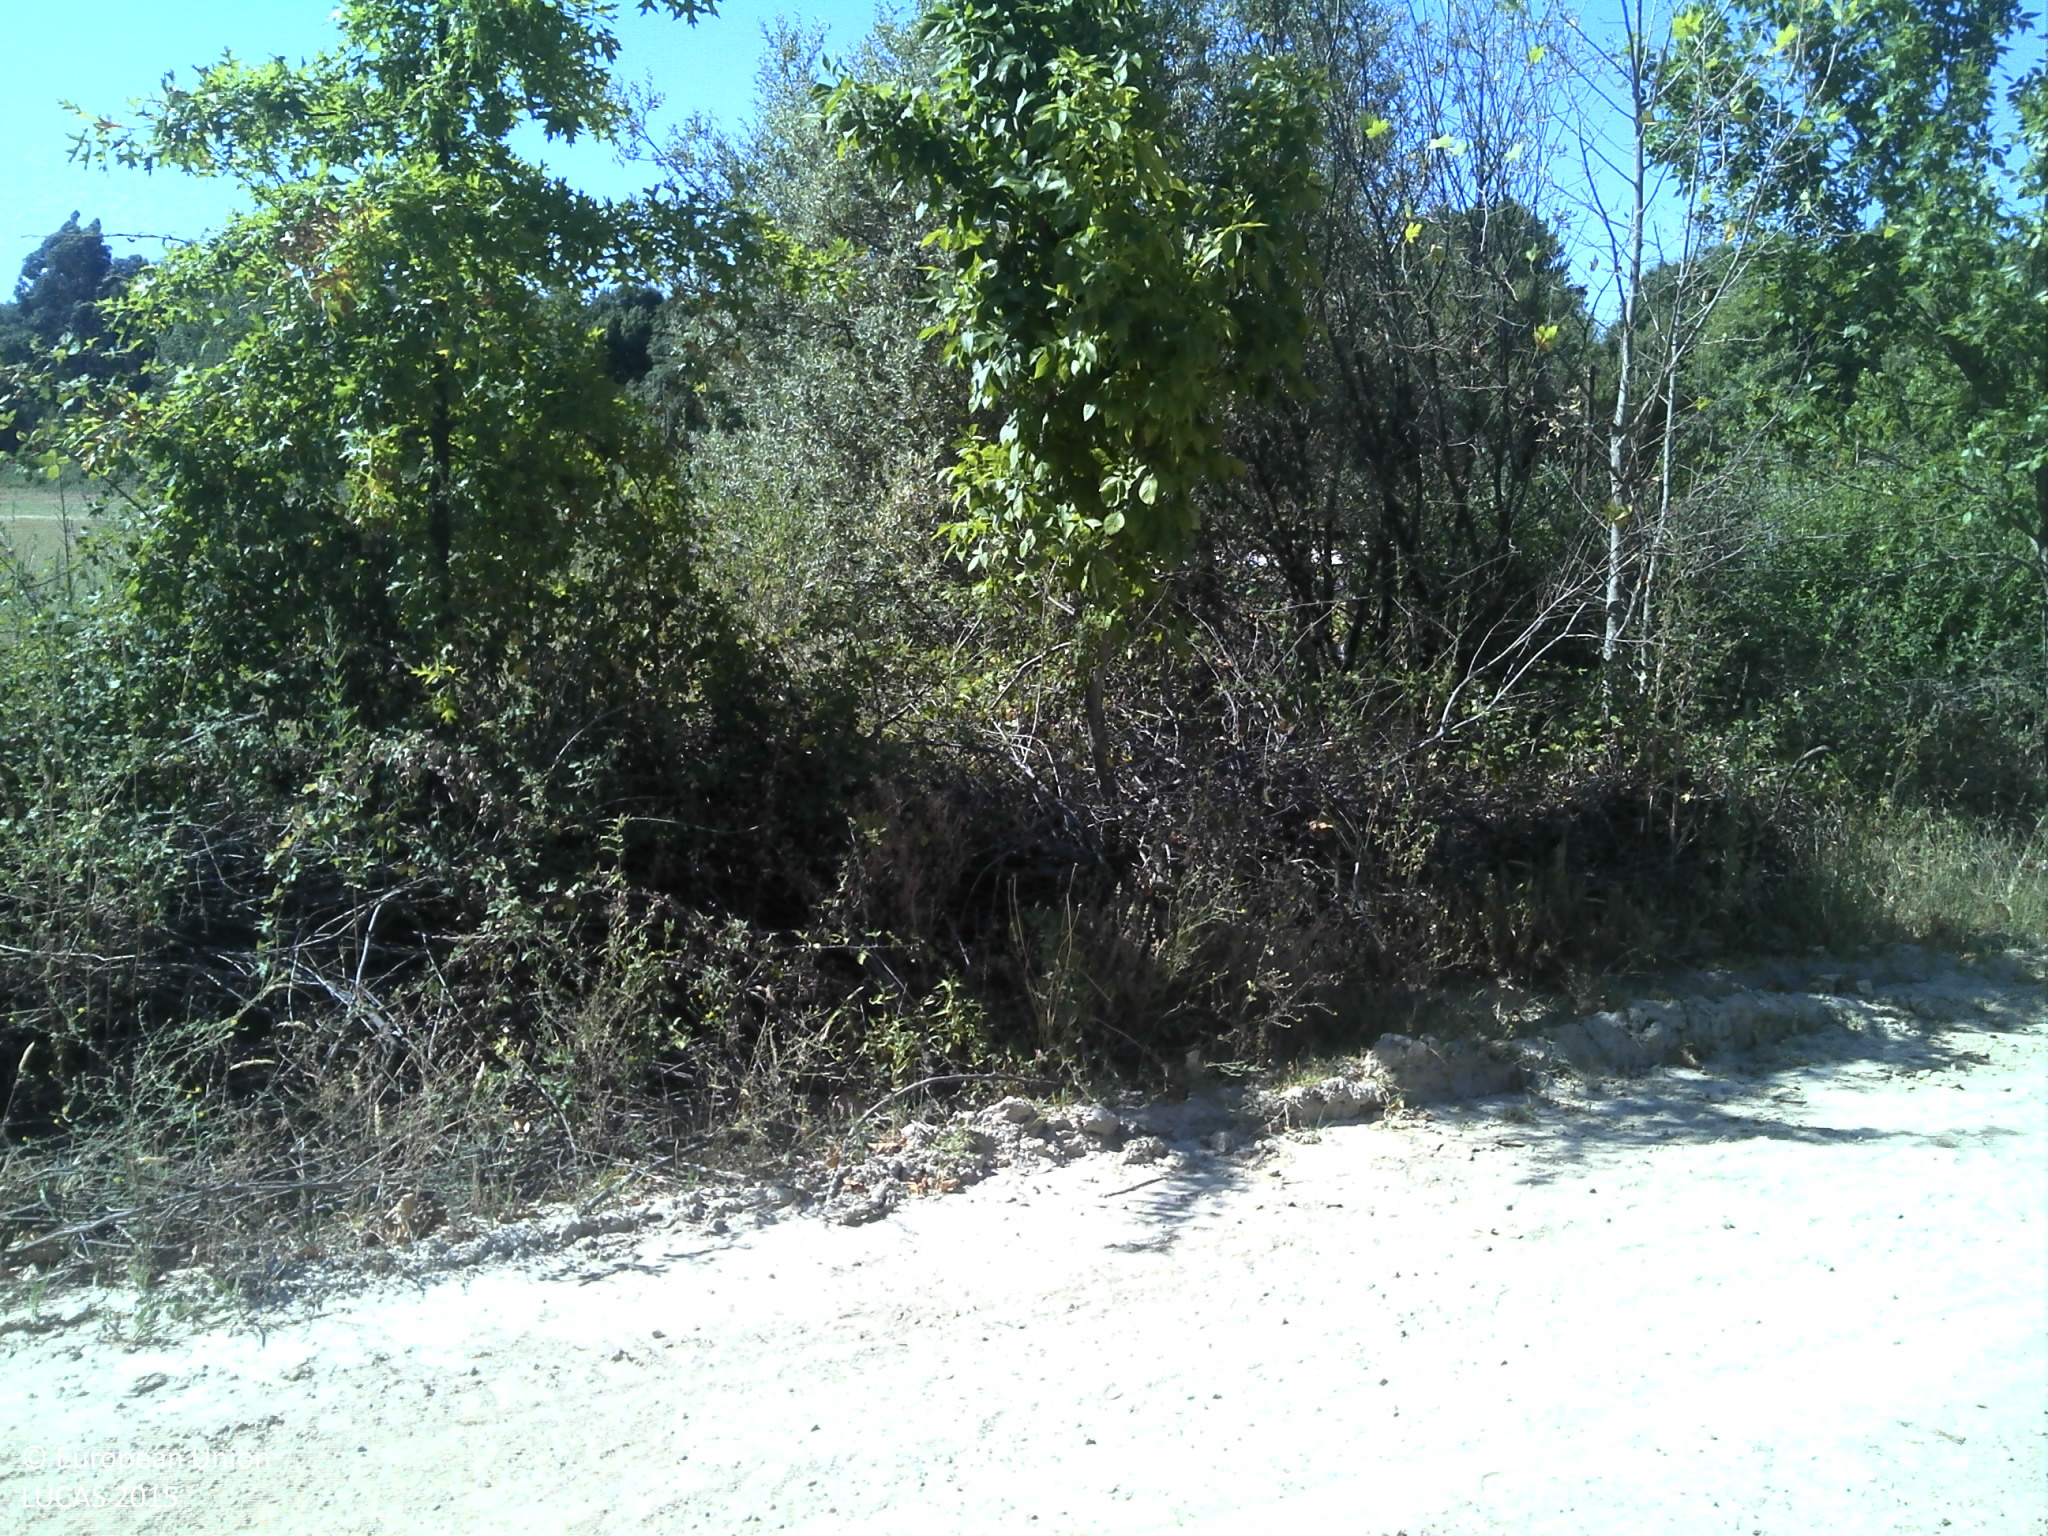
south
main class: Woodland
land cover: Broadleaved woodland
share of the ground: 25 - 50 %
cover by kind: shrubs 45 %, broadleaved forest trees 25 %, herbaceous plants 15 %, unconsolidated bare surface 15 %
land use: Semi-natural and natural areas not in use
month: July
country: PT
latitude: 40.3849
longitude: -7.3628
